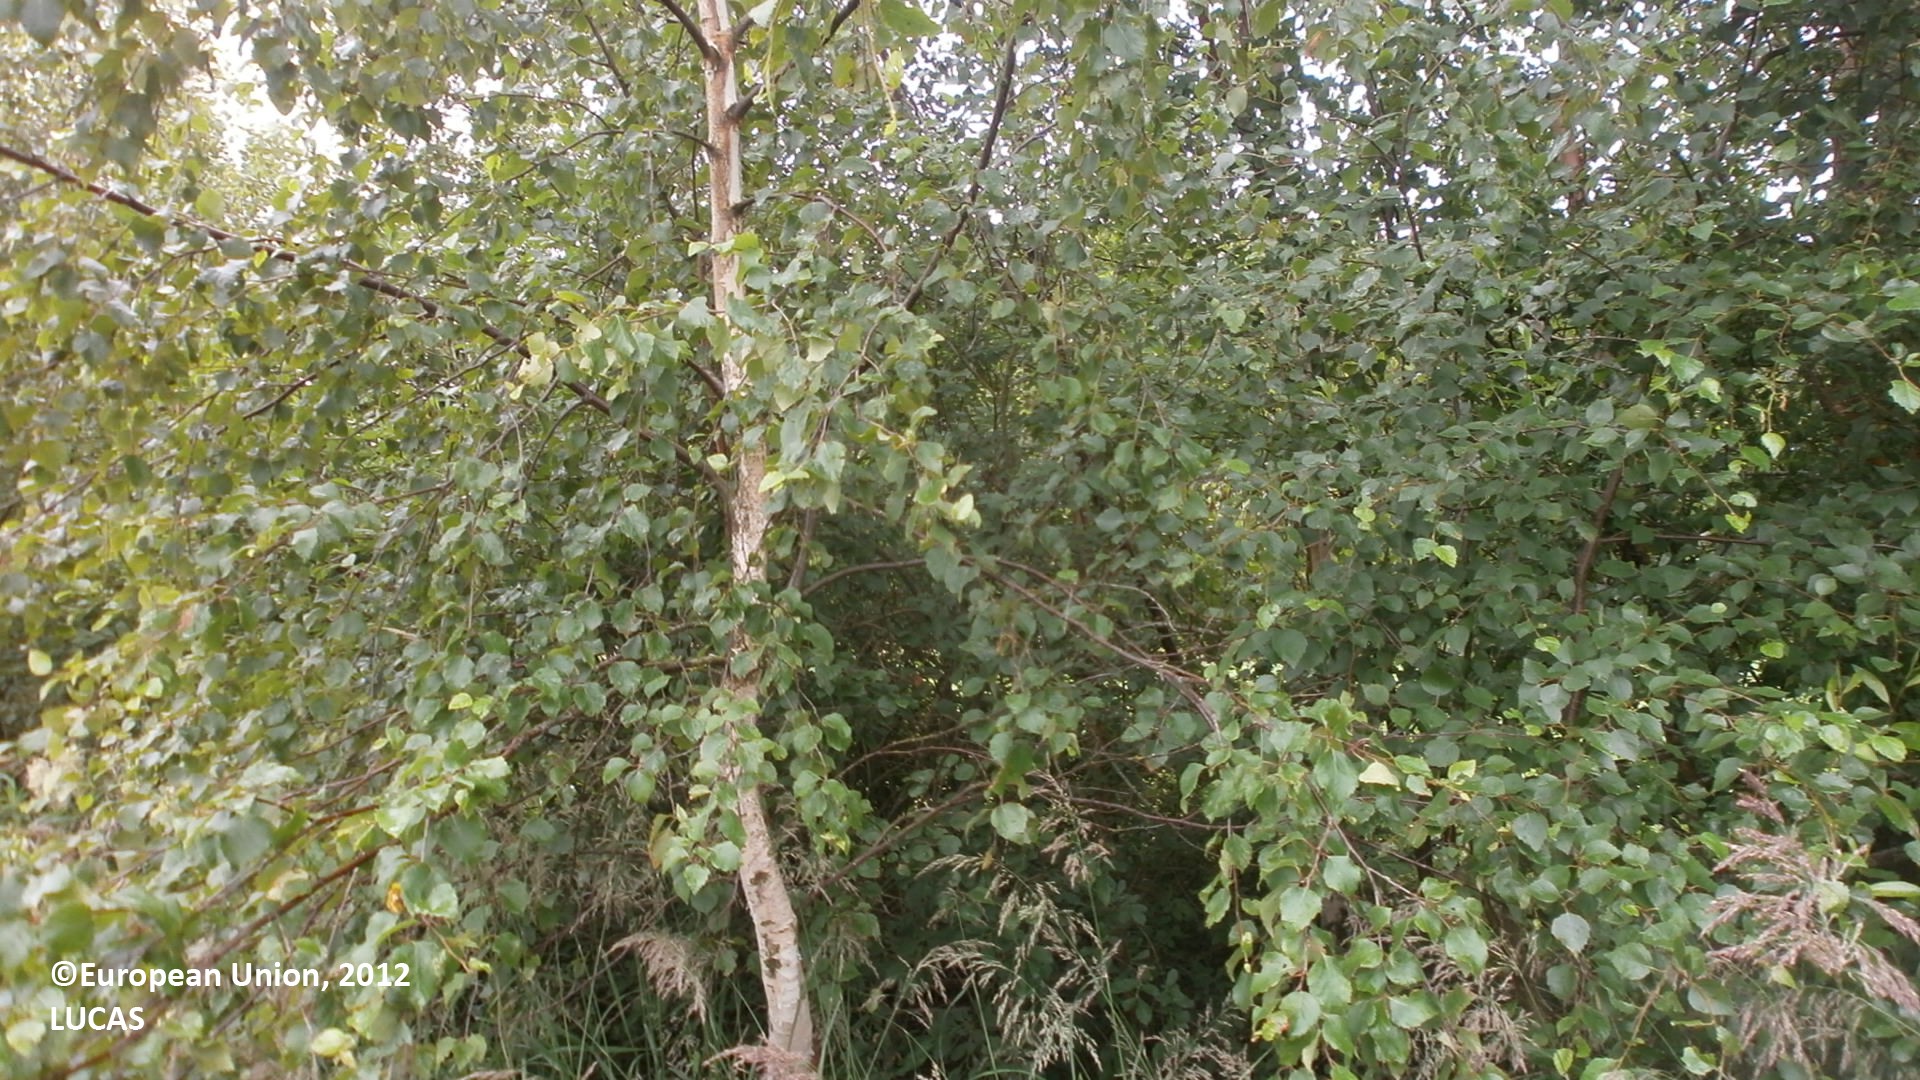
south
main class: Cropland
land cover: Potatoes
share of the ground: 50 - 75 %
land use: Agriculture (excluding fallow land and kitchen gardens)
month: July
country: FI
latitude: 64.0274
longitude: 23.6277
